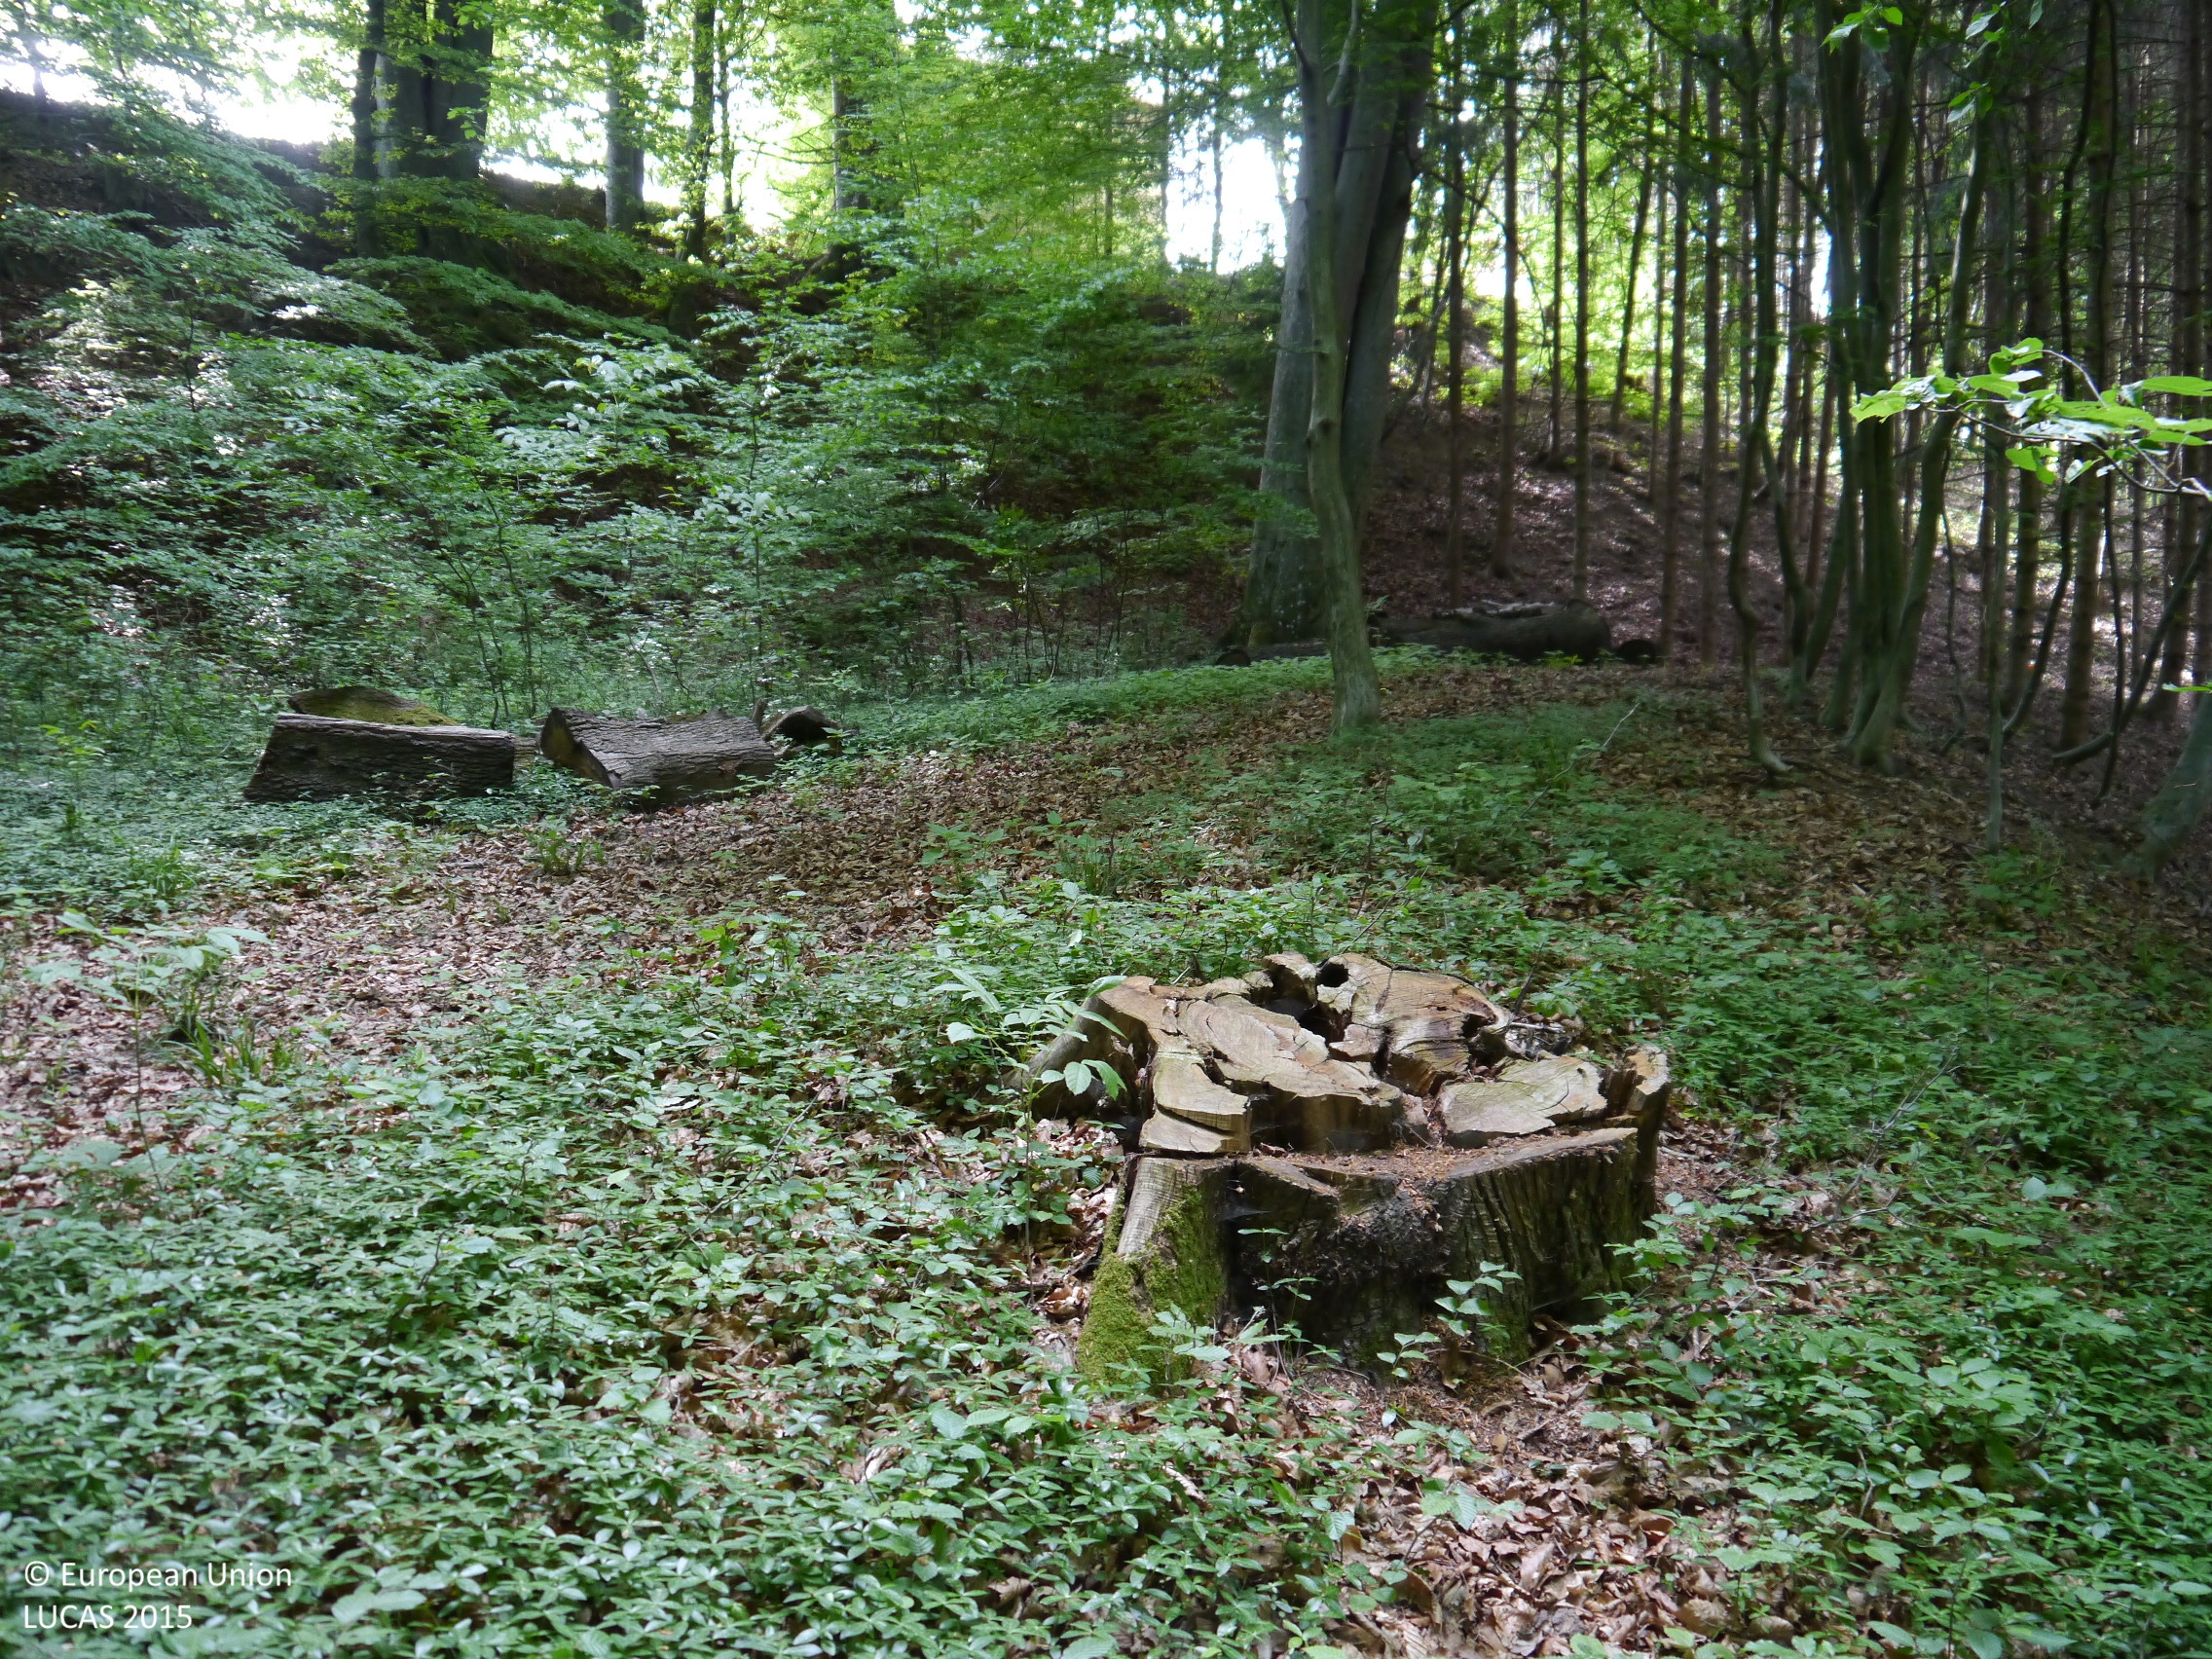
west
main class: Woodland
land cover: Broadleaved woodland
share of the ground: > 75 %
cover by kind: broadleaved forest trees 95 %, herbaceous plants 5 %
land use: Forestry
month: May
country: AT
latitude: 46.9593
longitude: 15.6639
